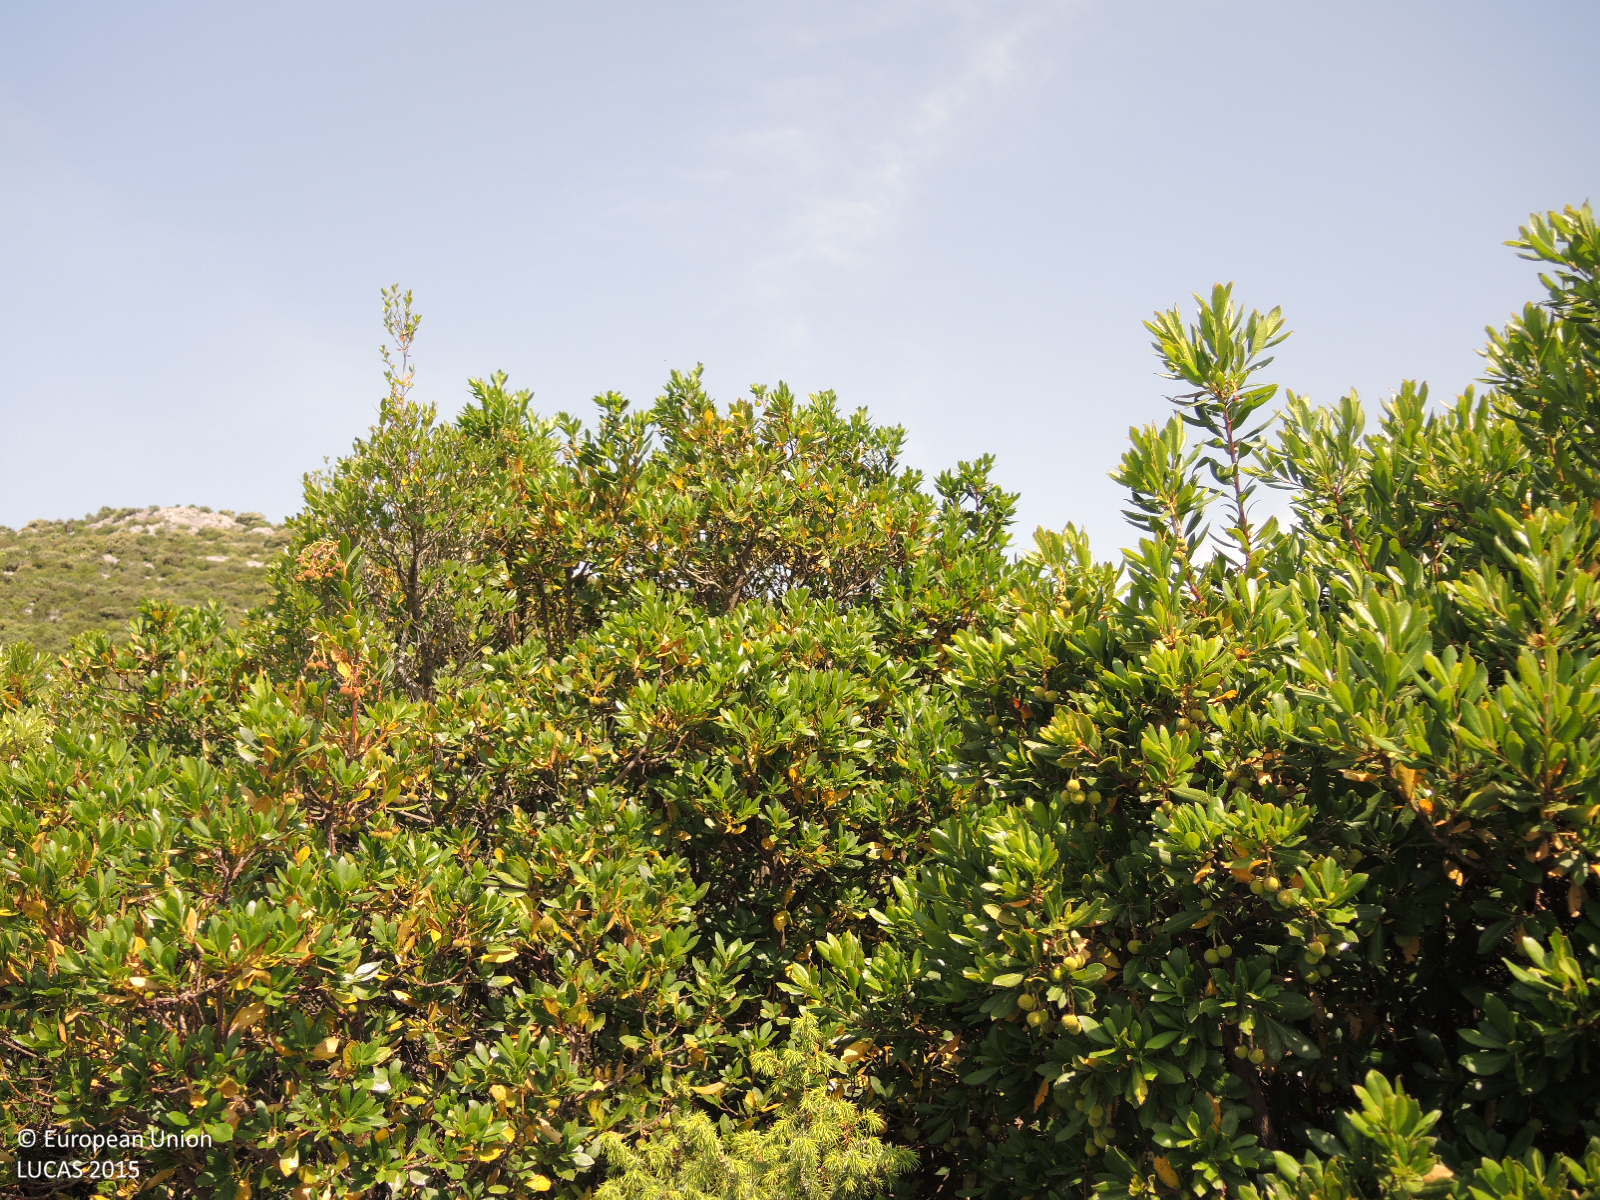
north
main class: Shrubland
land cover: Shrubland without tree cover
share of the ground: > 75 %
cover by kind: shrubs 70 %, herbaceous plants 20 %, unconsolidated bare surface 10 %
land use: Semi-natural and natural areas not in use
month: May
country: HR
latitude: 43.8503
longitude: 15.7011
